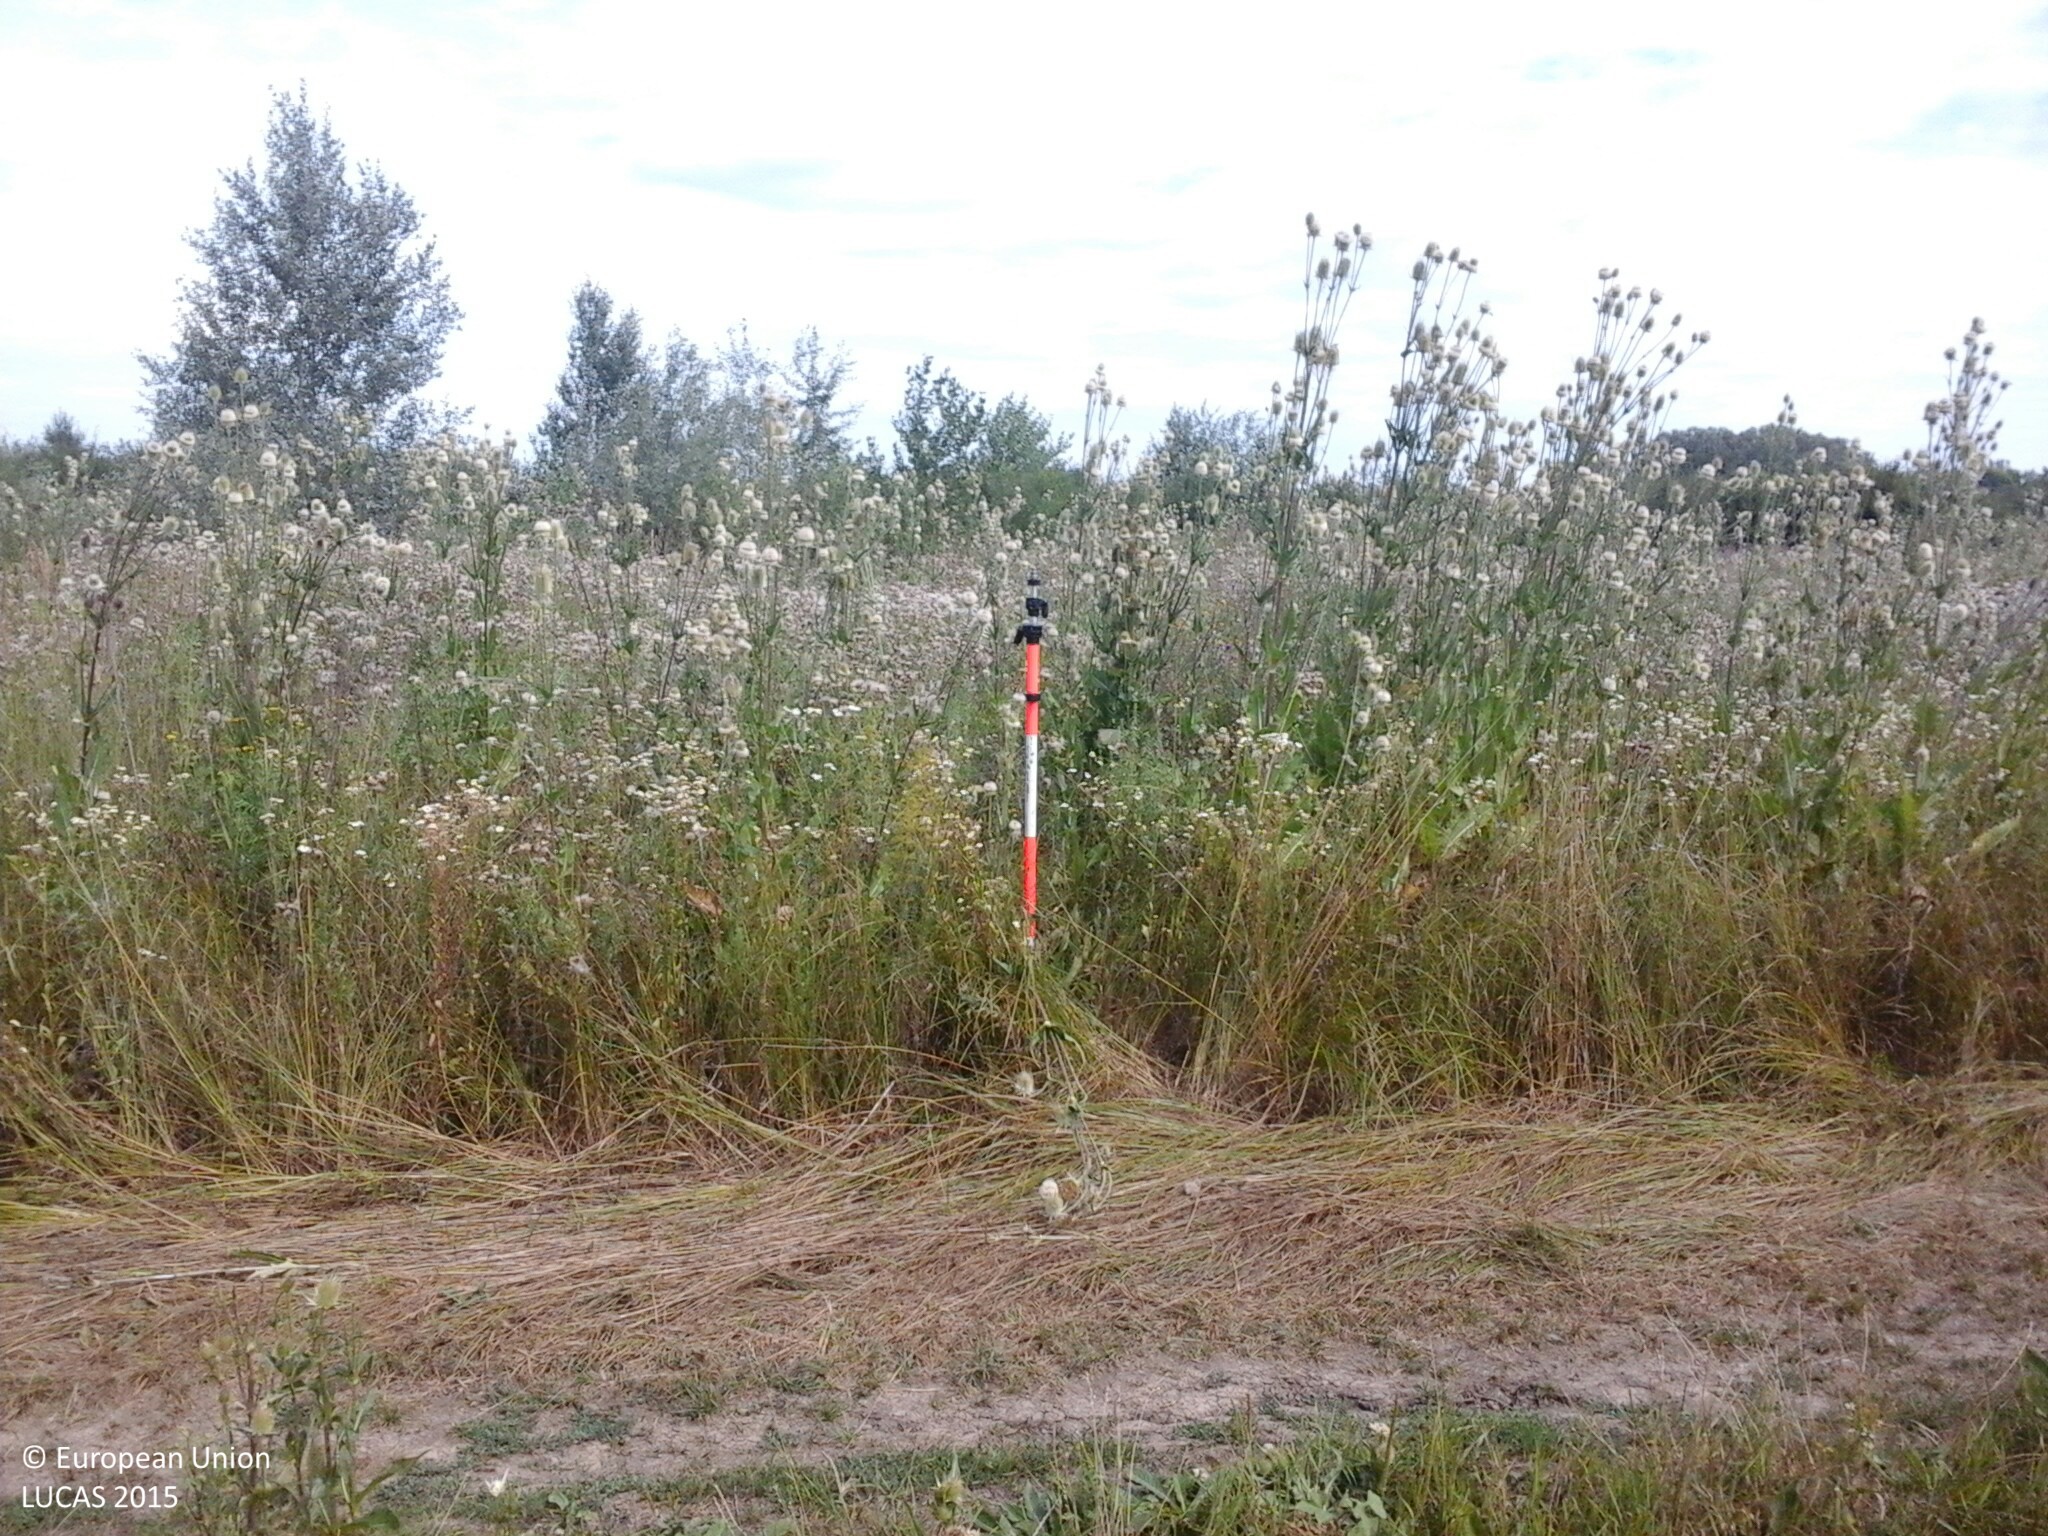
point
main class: Grassland
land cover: Spontaneously vegetated surfaces
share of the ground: > 75 %
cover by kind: herbaceous plants 100 %
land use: Semi-natural and natural areas not in use
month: July
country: HU
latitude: 48.0466
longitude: 22.4133
